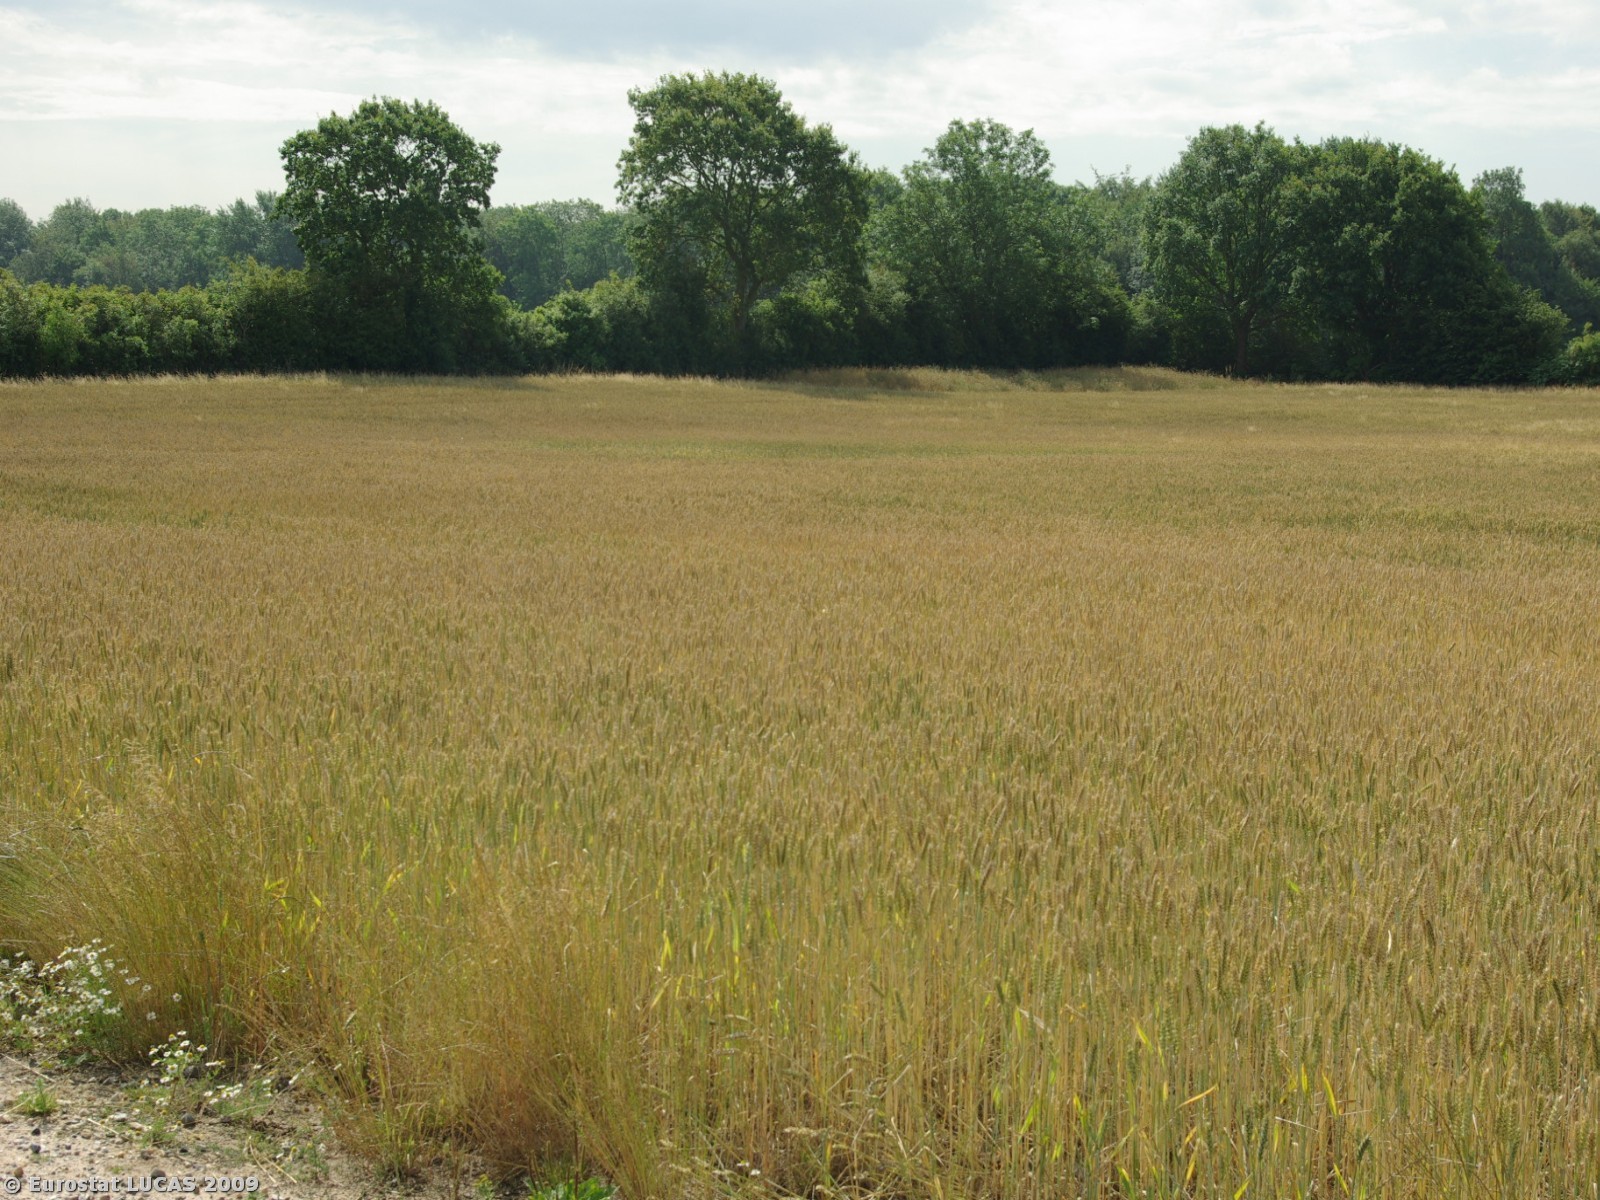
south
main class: Cropland
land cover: Barley
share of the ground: > 75 %
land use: Agriculture (excluding fallow land and kitchen gardens)
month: July
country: DK
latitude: 54.9115
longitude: 9.8597
